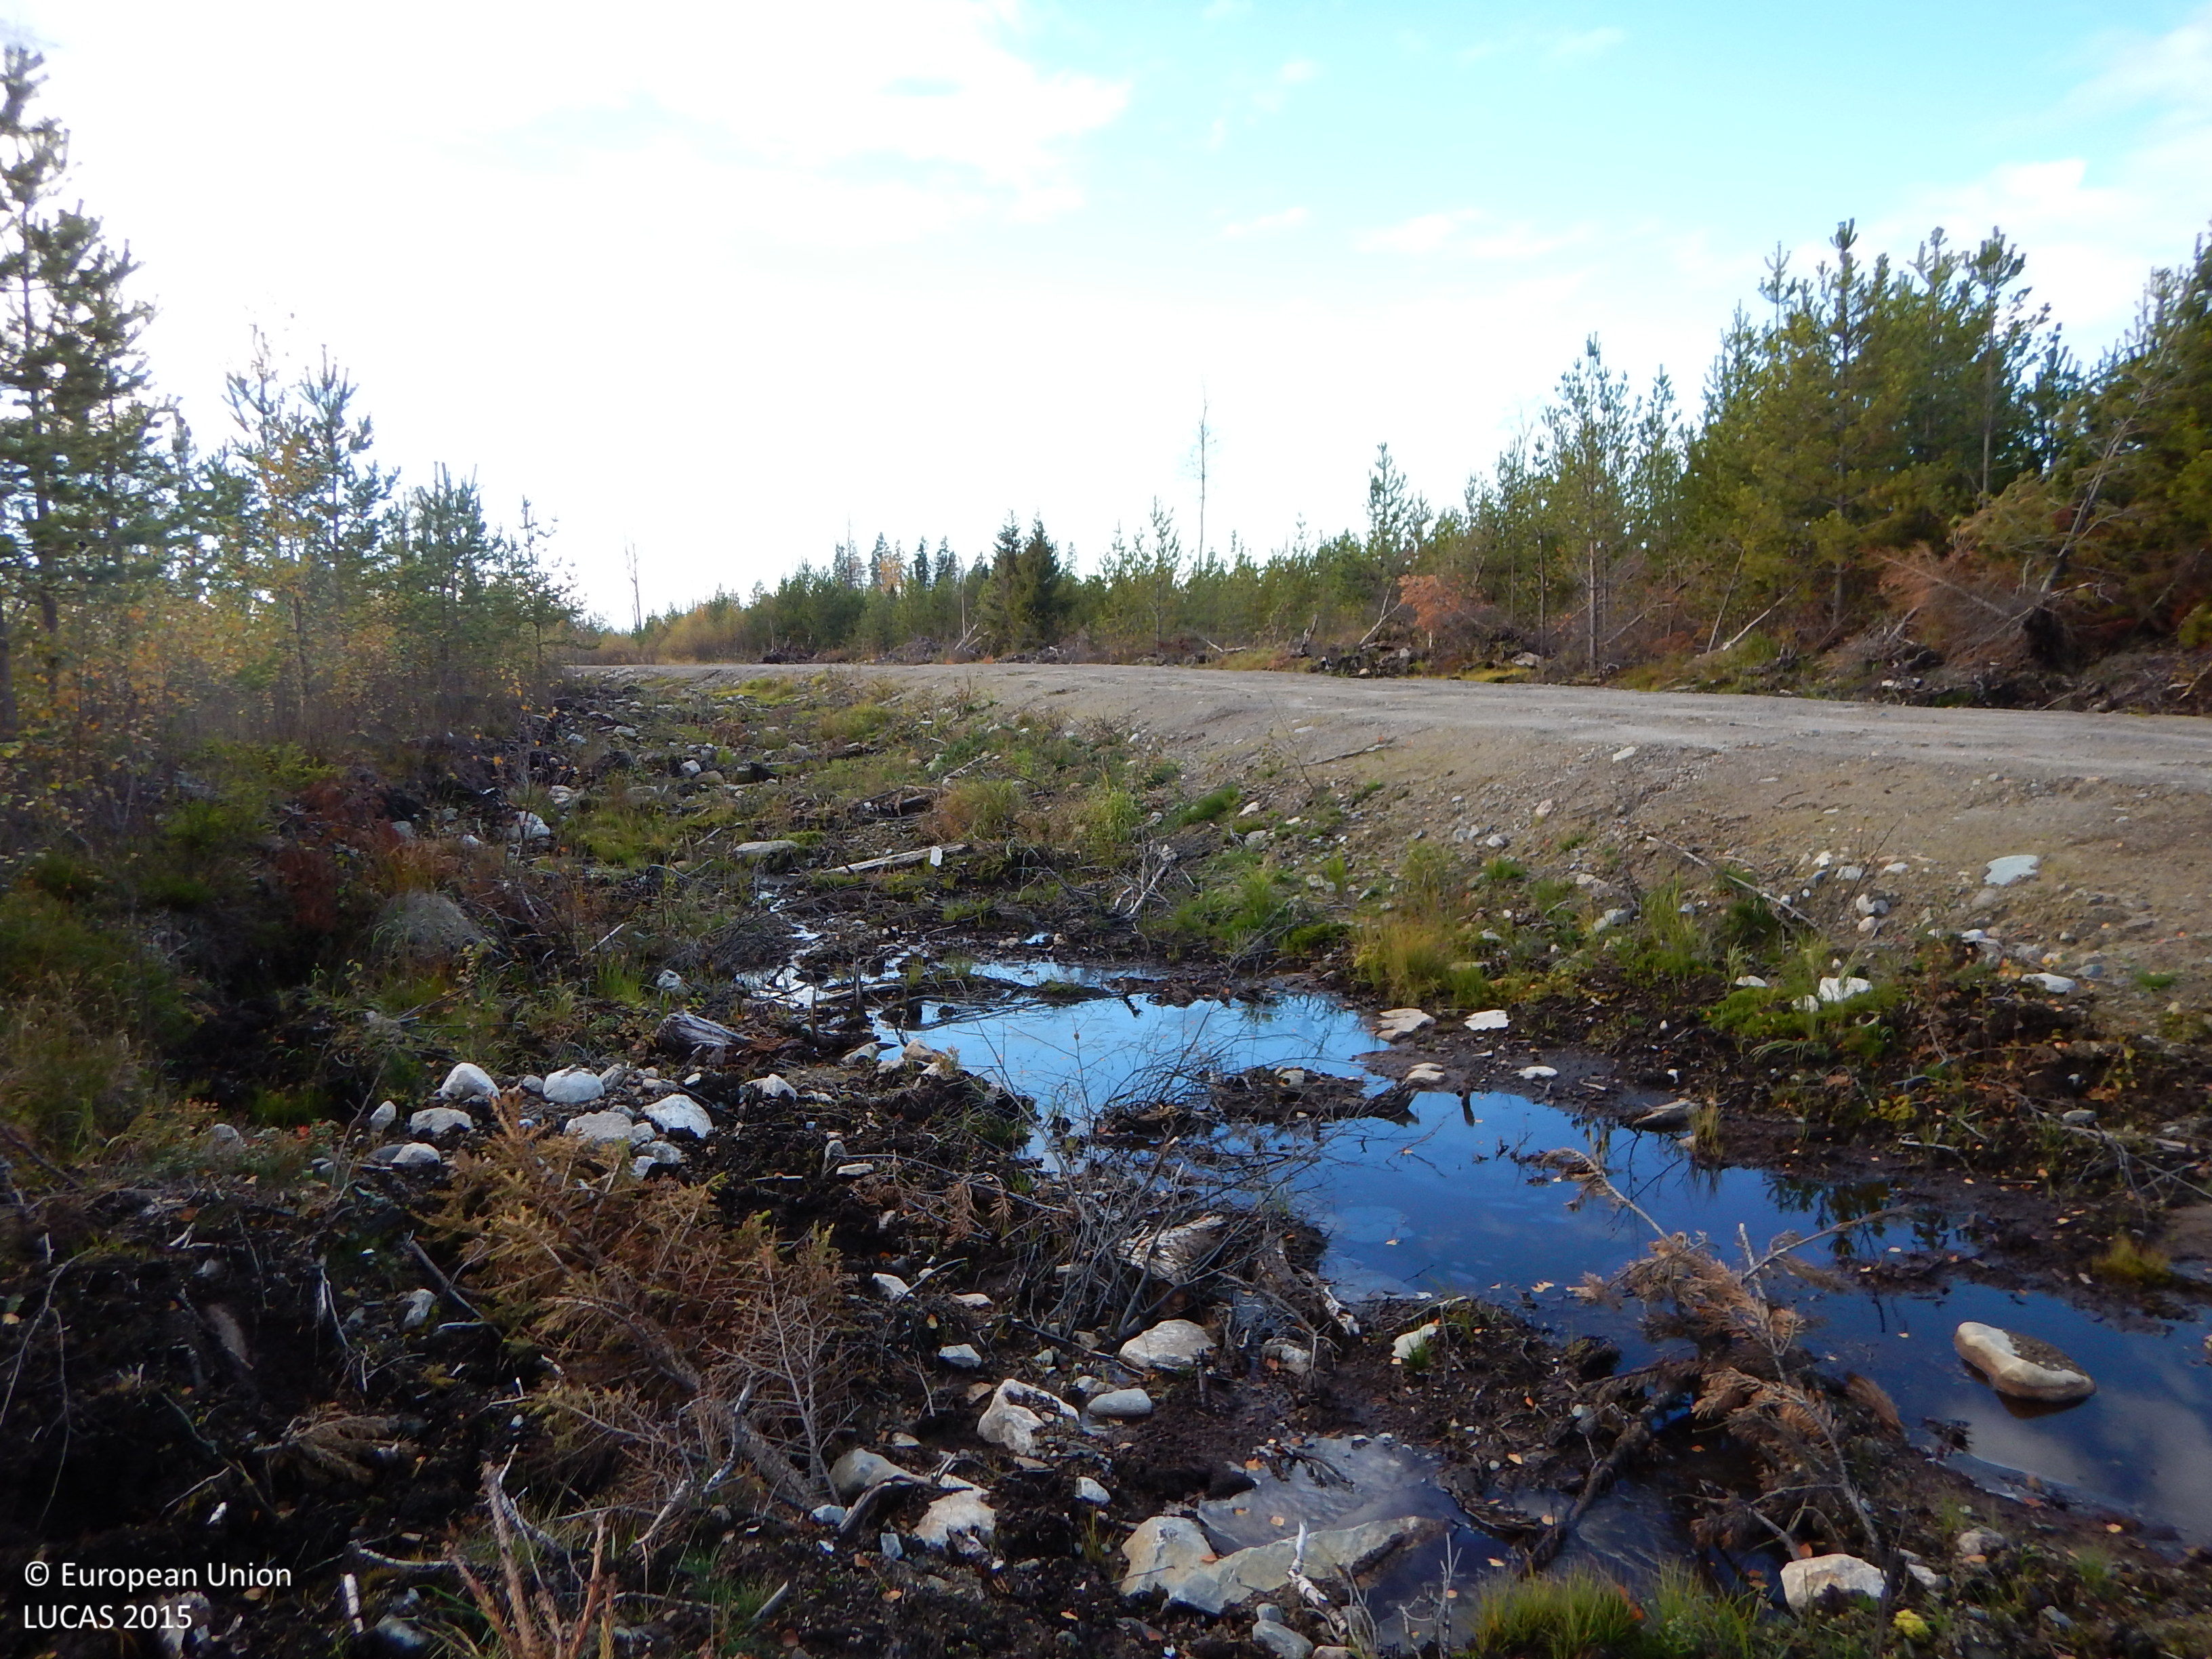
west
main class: Woodland
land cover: Other mixed woodland
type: boreal forest
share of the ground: 50 - 75 %
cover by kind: coniferous forest trees 45 %, broadleaved forest trees 25 %, herbaceous plants 15 %, shrubs 10 %, lichens and mosses 5 %
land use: Forestry
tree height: < 5 m
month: October
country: SE
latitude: 64.9822
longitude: 21.0174
